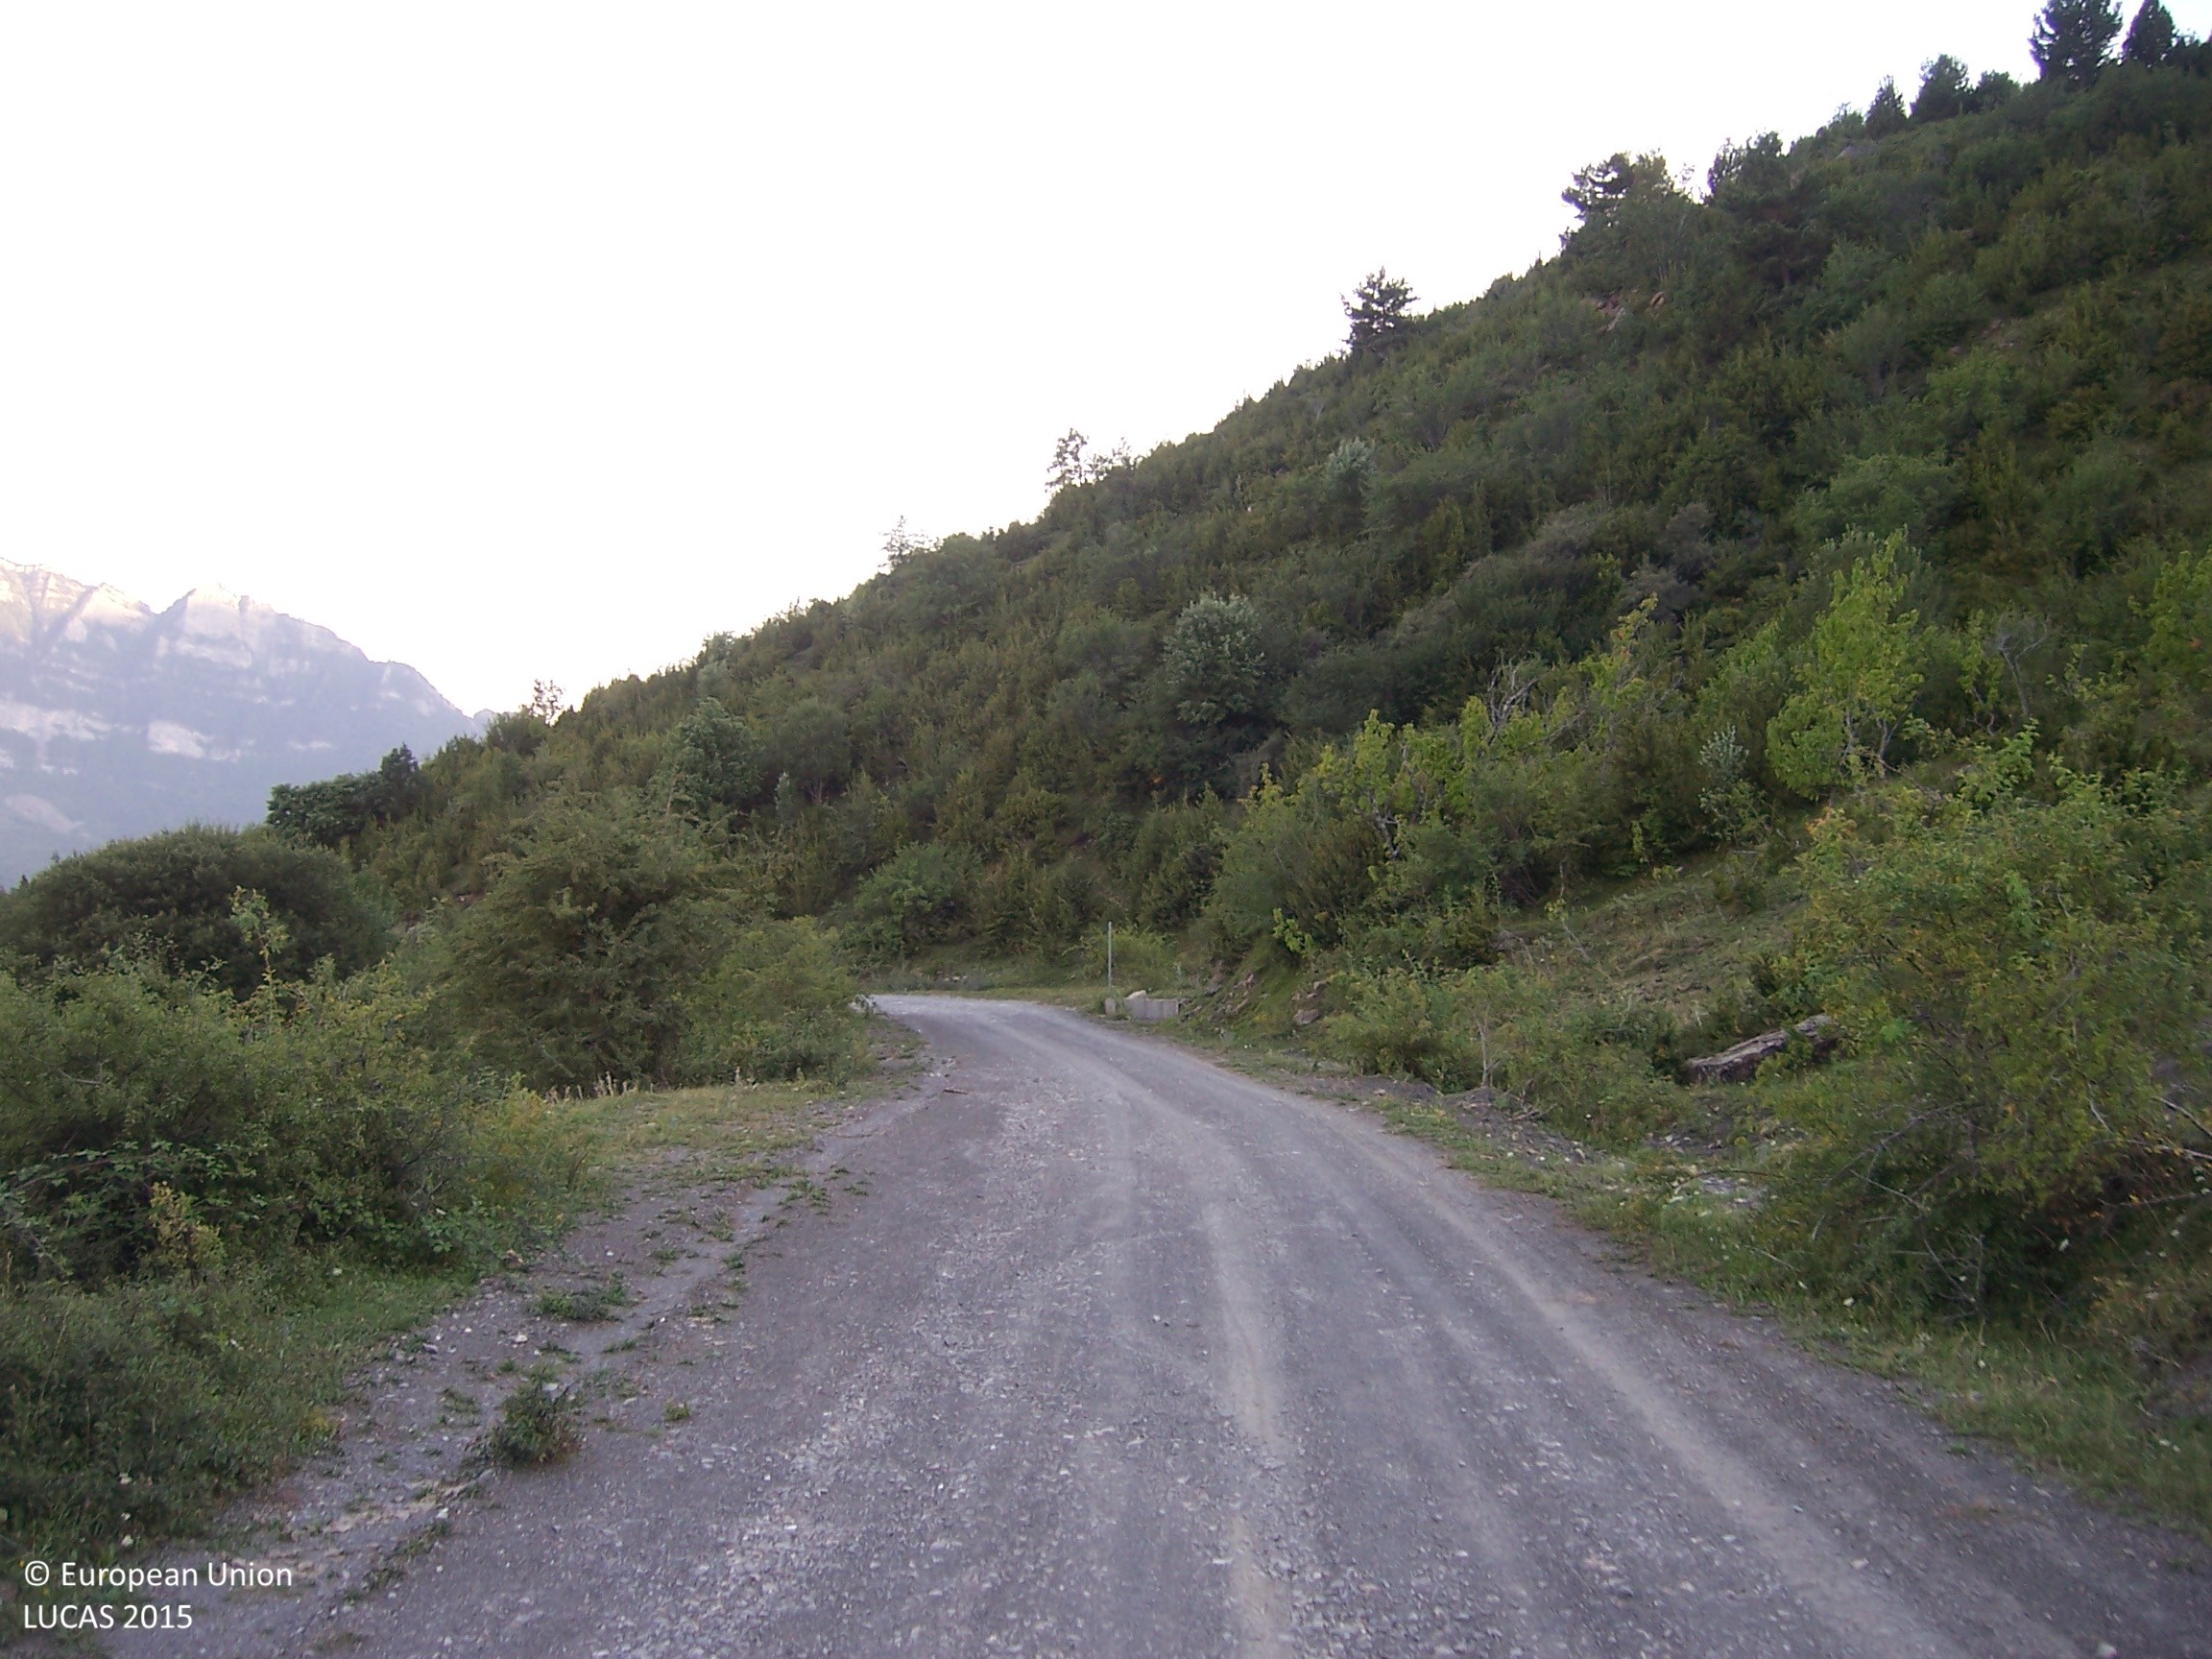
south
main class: Grassland
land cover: Grassland without tree/shrub cover
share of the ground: > 75 %
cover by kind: herbaceous plants 60 %, consolidated bare surface 40 %
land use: Agriculture (excluding fallow land and kitchen gardens)
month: August
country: ES
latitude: 42.7385
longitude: -0.3733
